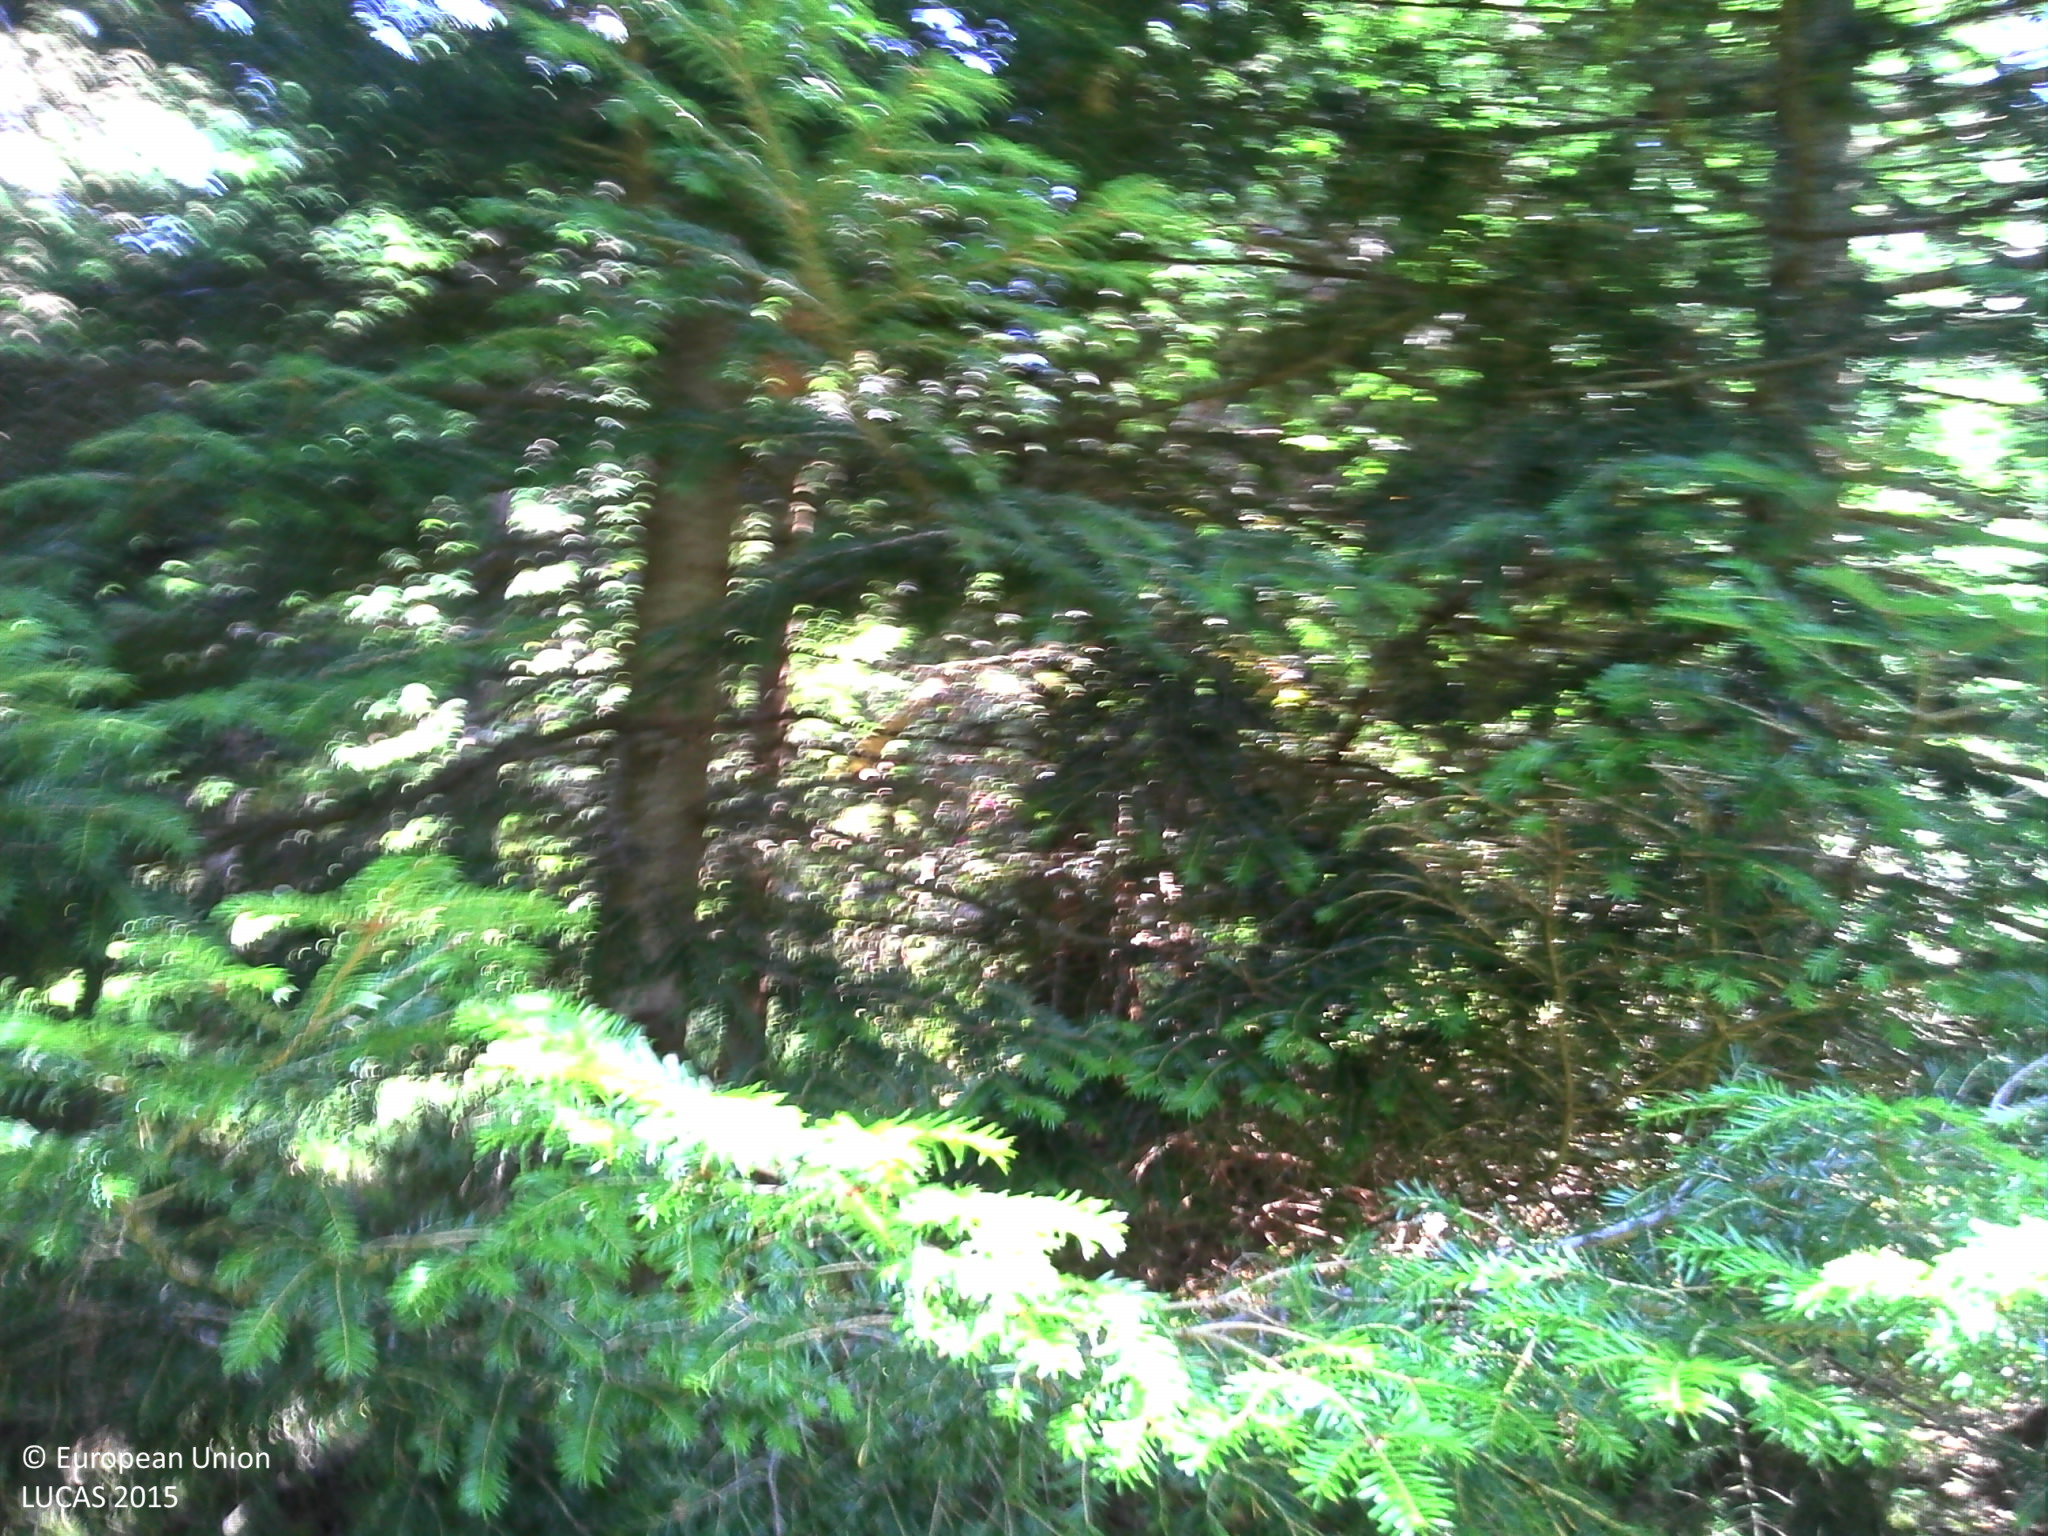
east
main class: Woodland
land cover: Spruce dominated coniferous woodland
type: exotic forest
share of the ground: > 75 %
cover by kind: coniferous forest trees 80 %, shrubs 10 %, herbaceous plants 10 %
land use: Forestry
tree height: > 5 m
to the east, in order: Spruce dominated coniferous woodland; Tracks; Spruce dominated coniferous woodland
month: July
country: FR
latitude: 44.9020
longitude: 3.4309
